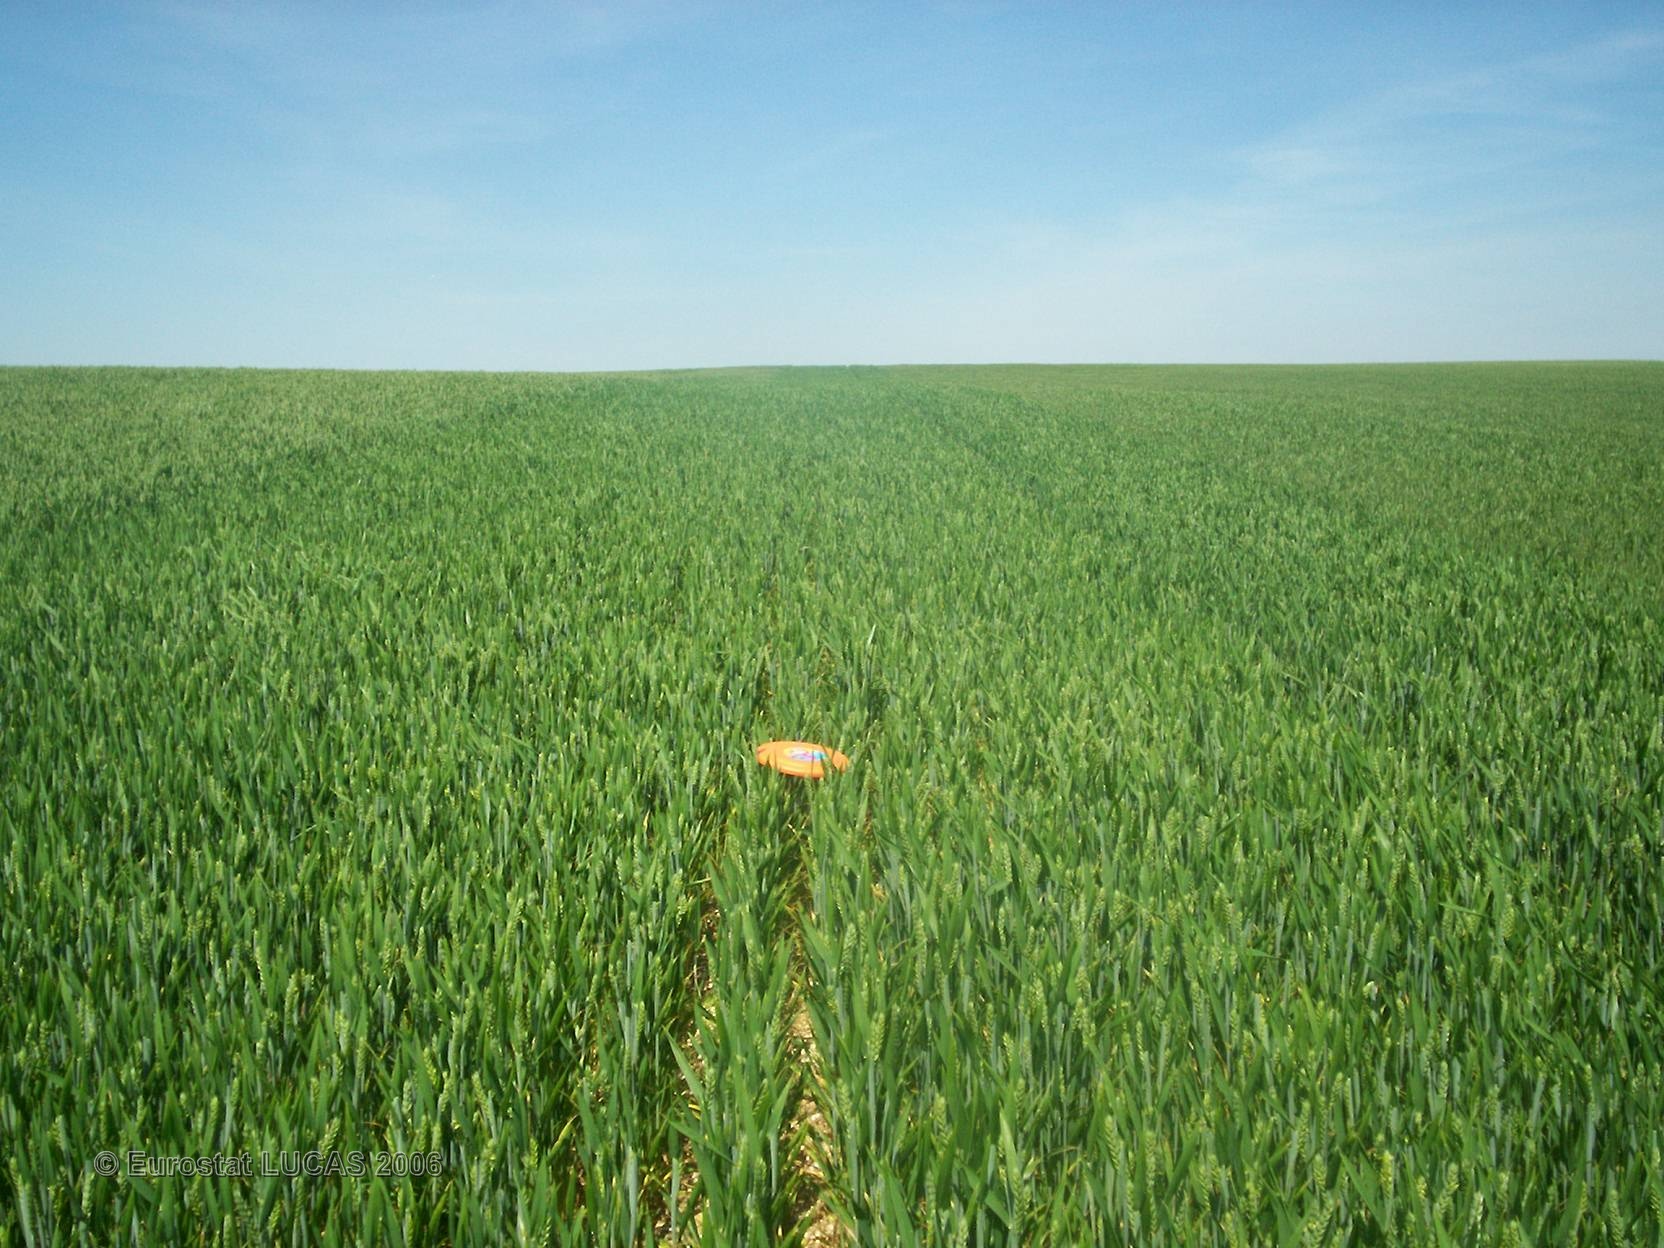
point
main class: Cropland
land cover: Common wheat
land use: Agriculture (excluding fallow land and kitchen gardens)
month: June
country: FR
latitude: 50.2522
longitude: 2.6251
